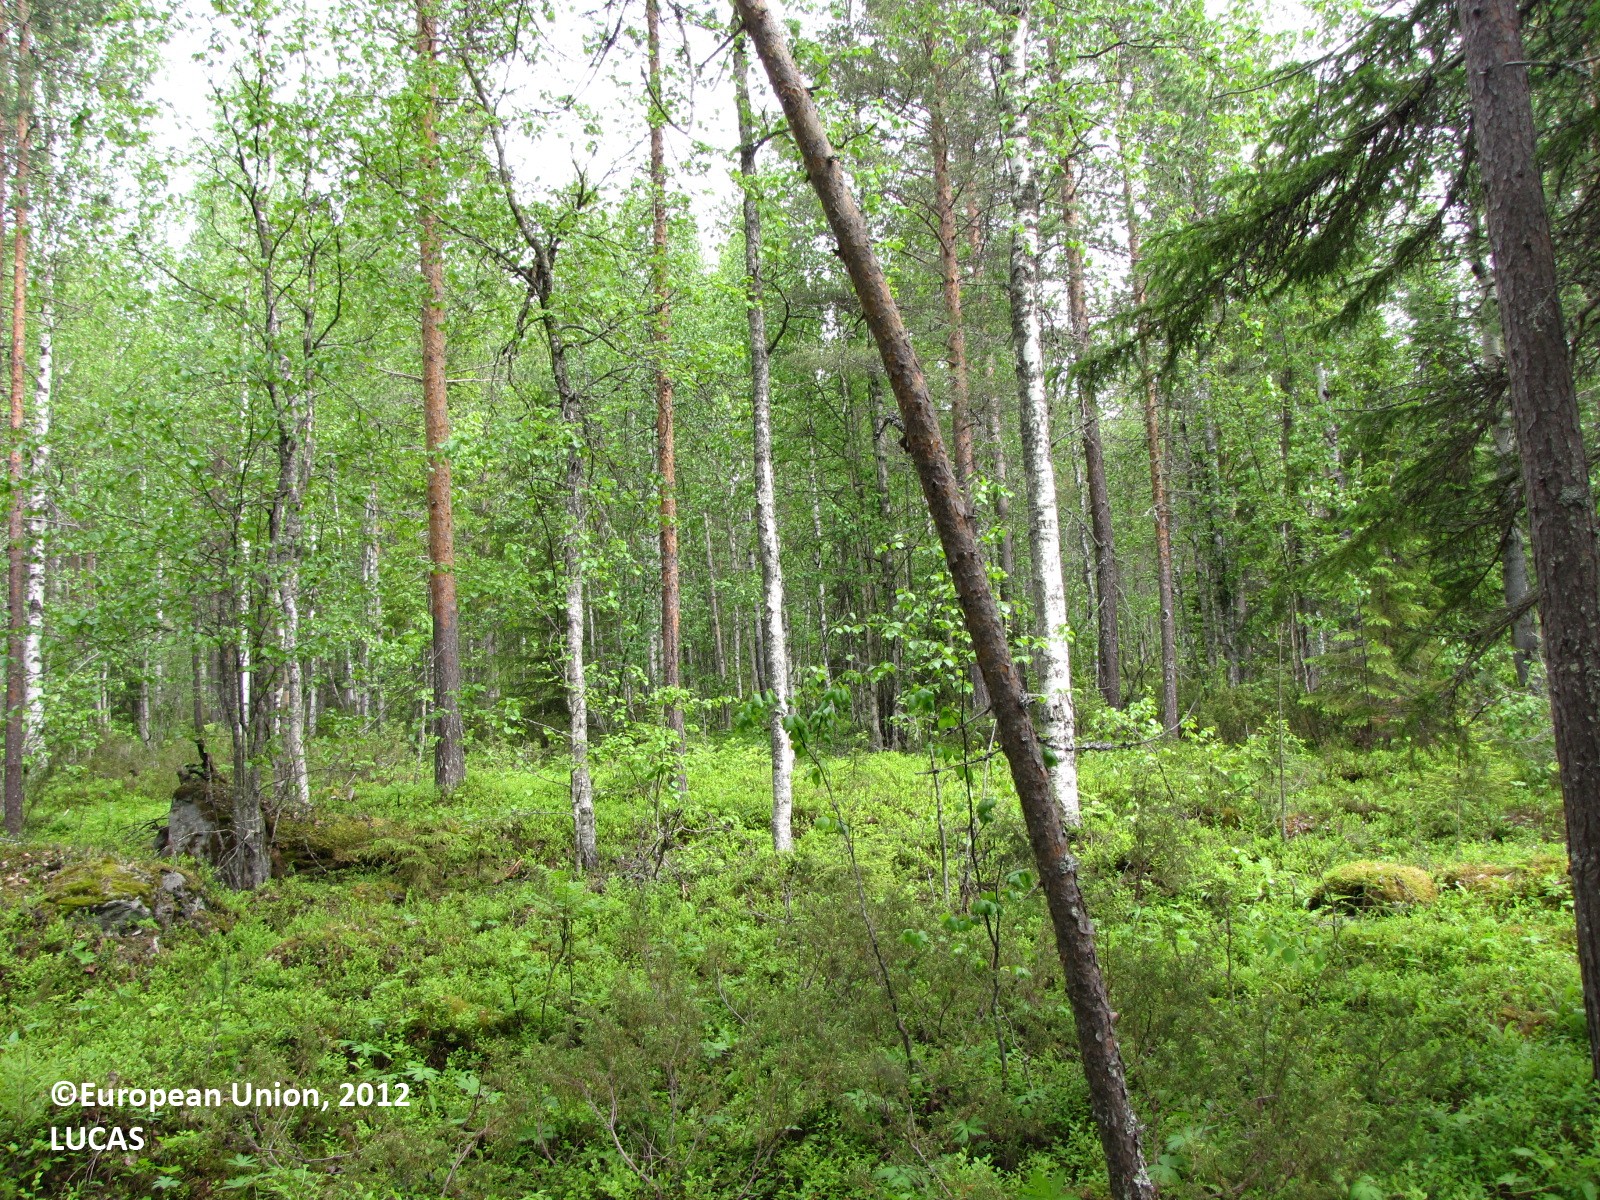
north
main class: Woodland
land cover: Pine dominated mixed woodland
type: boreal forest
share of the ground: 10 - 25 %
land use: Forestry
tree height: > 5 m
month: June
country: FI
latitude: 66.2318
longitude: 24.9768
